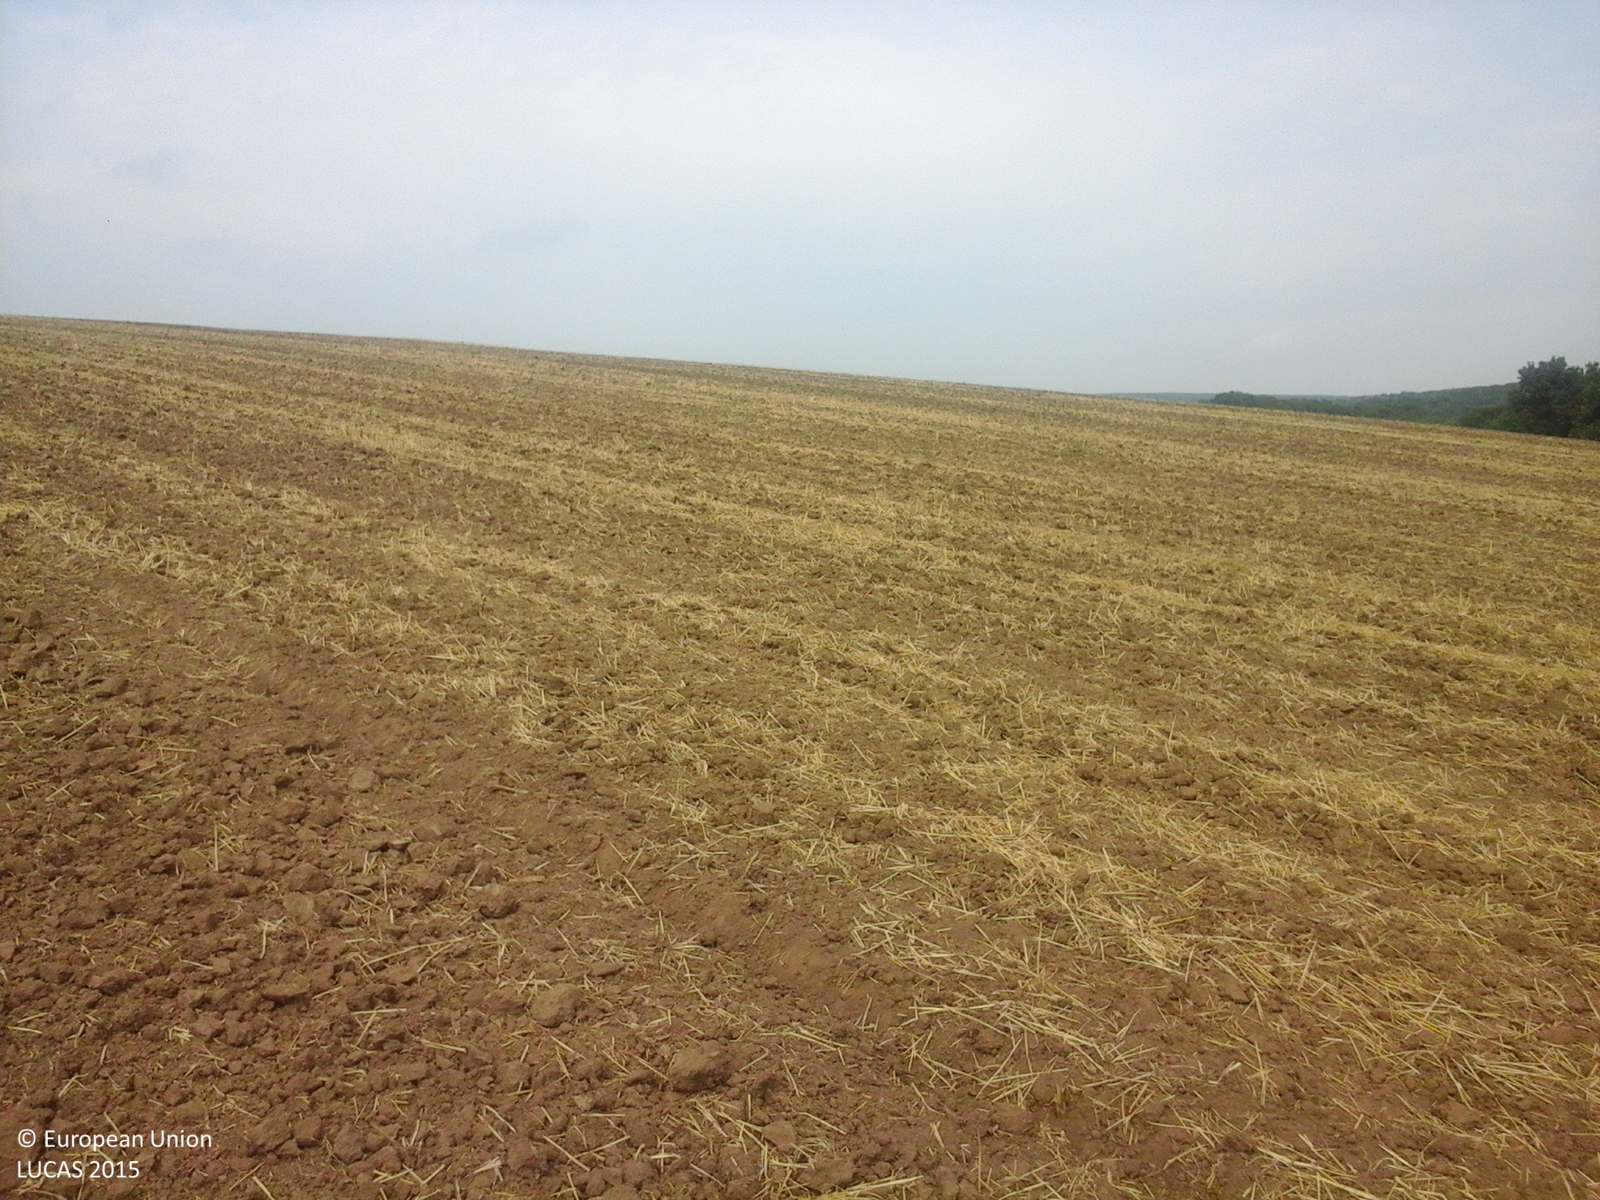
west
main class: Cropland
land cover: Durum wheat
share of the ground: < 10 %
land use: Agriculture (excluding fallow land and kitchen gardens)
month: July
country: RO
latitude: 44.9857
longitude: 28.4537
